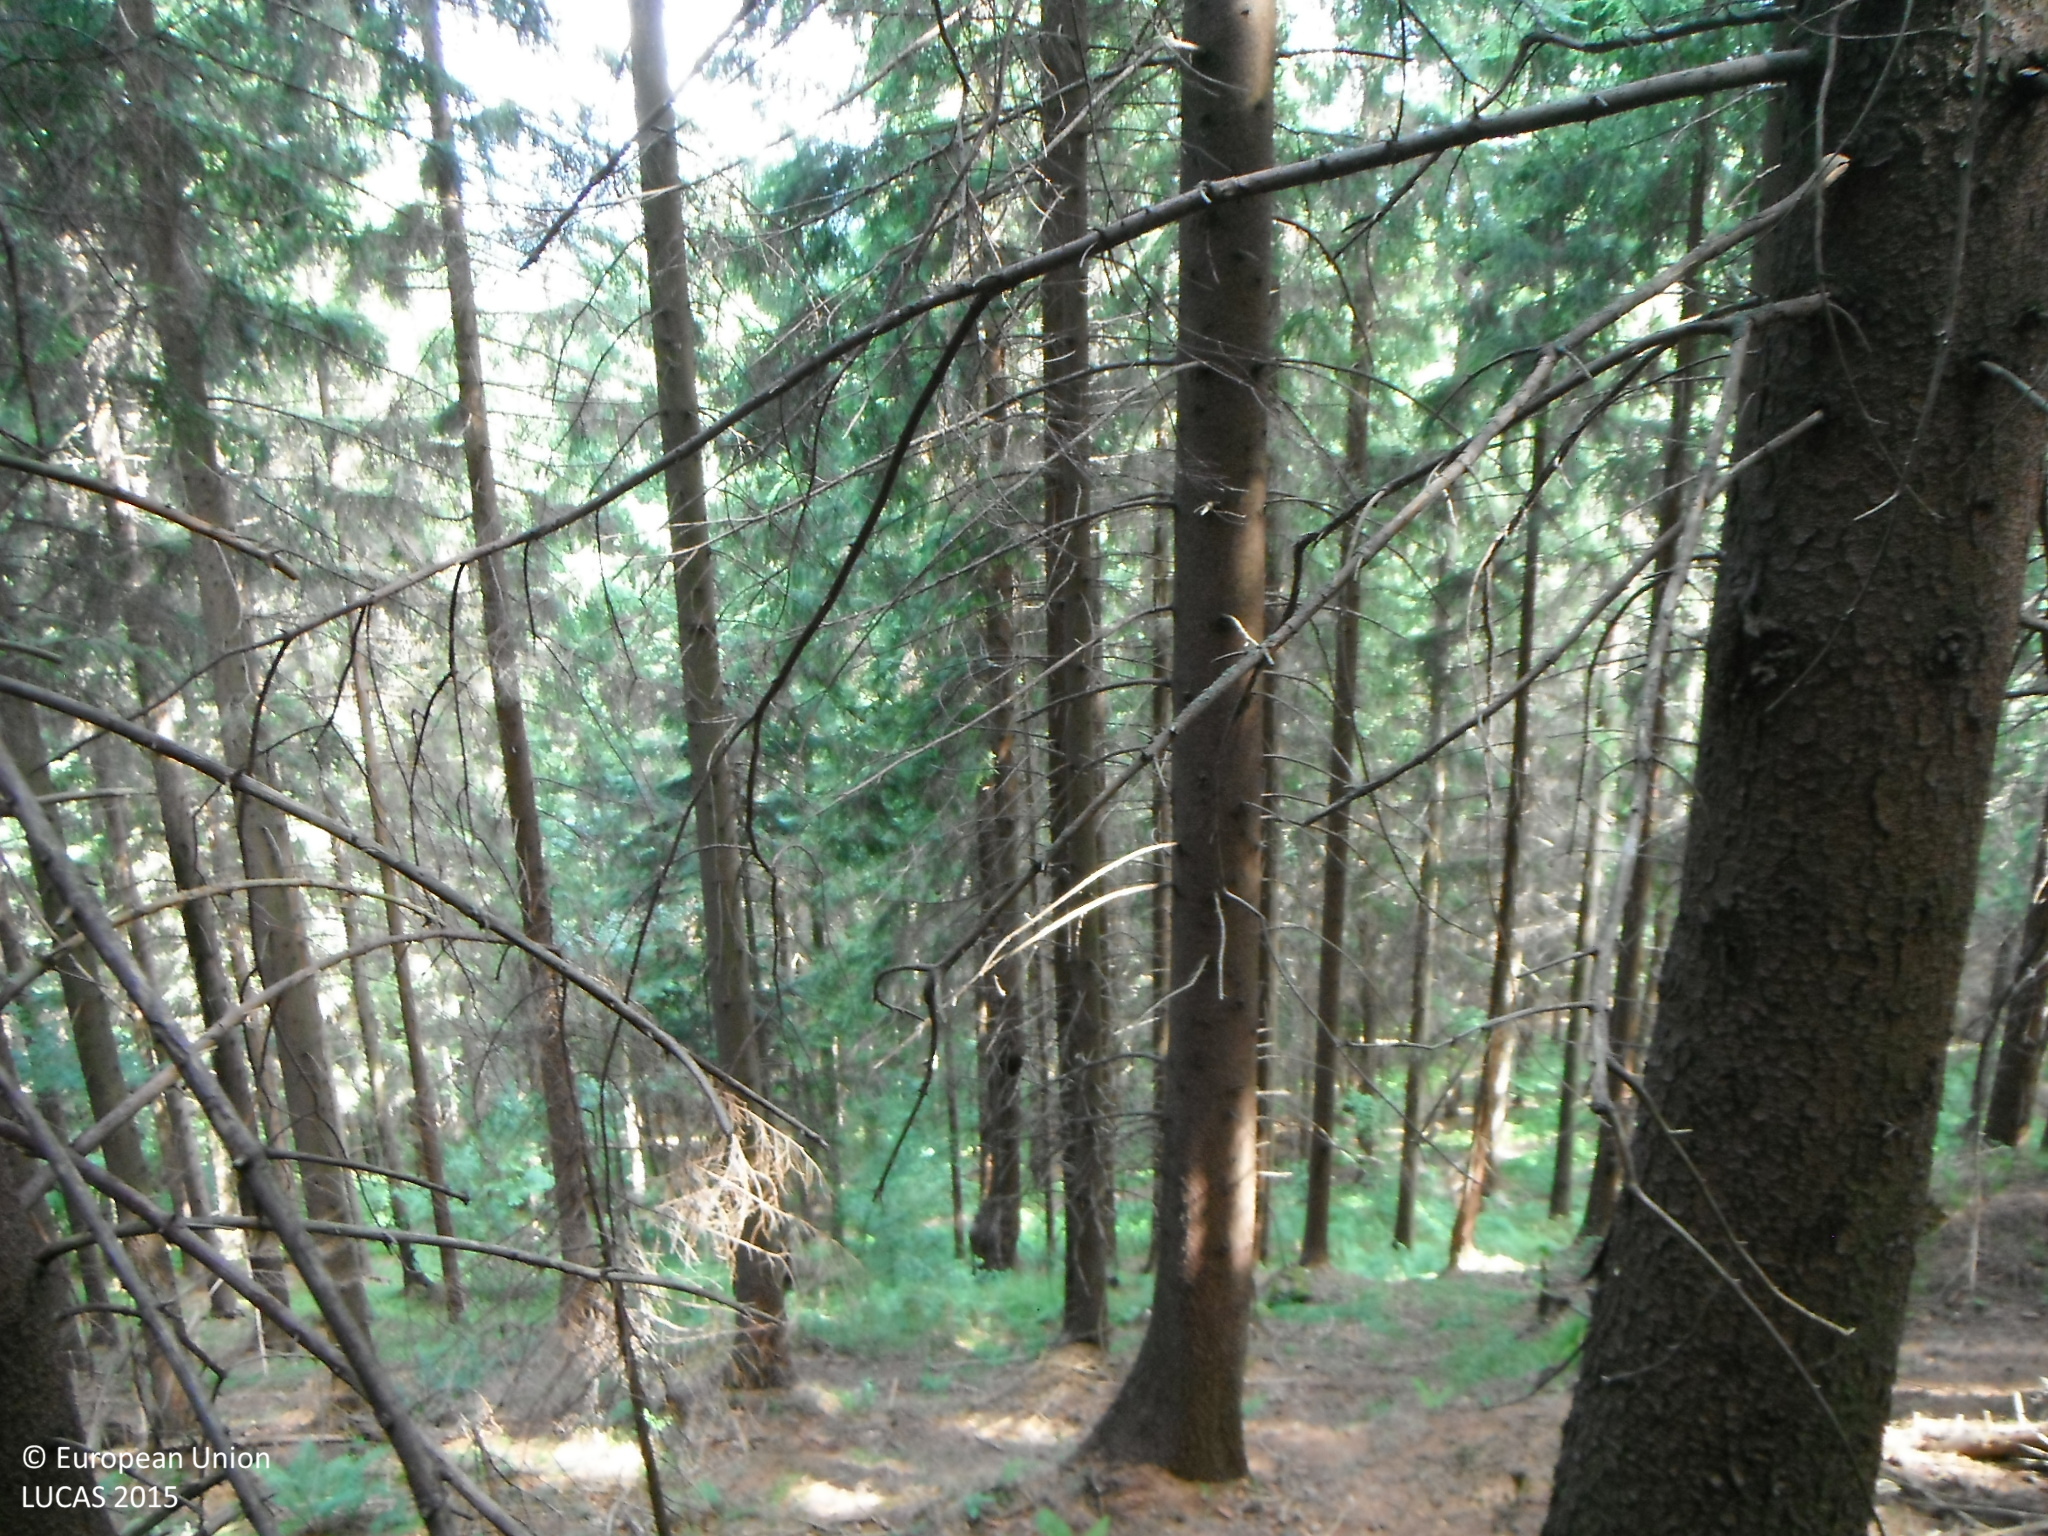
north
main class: Woodland
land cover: Spruce dominated coniferous woodland
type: alpine coniferous forest
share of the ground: > 75 %
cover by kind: coniferous forest trees 95 %, broadleaved forest trees 5 %
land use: Forestry
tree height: > 5 m
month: July
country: SK
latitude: 49.2560
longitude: 19.1324
